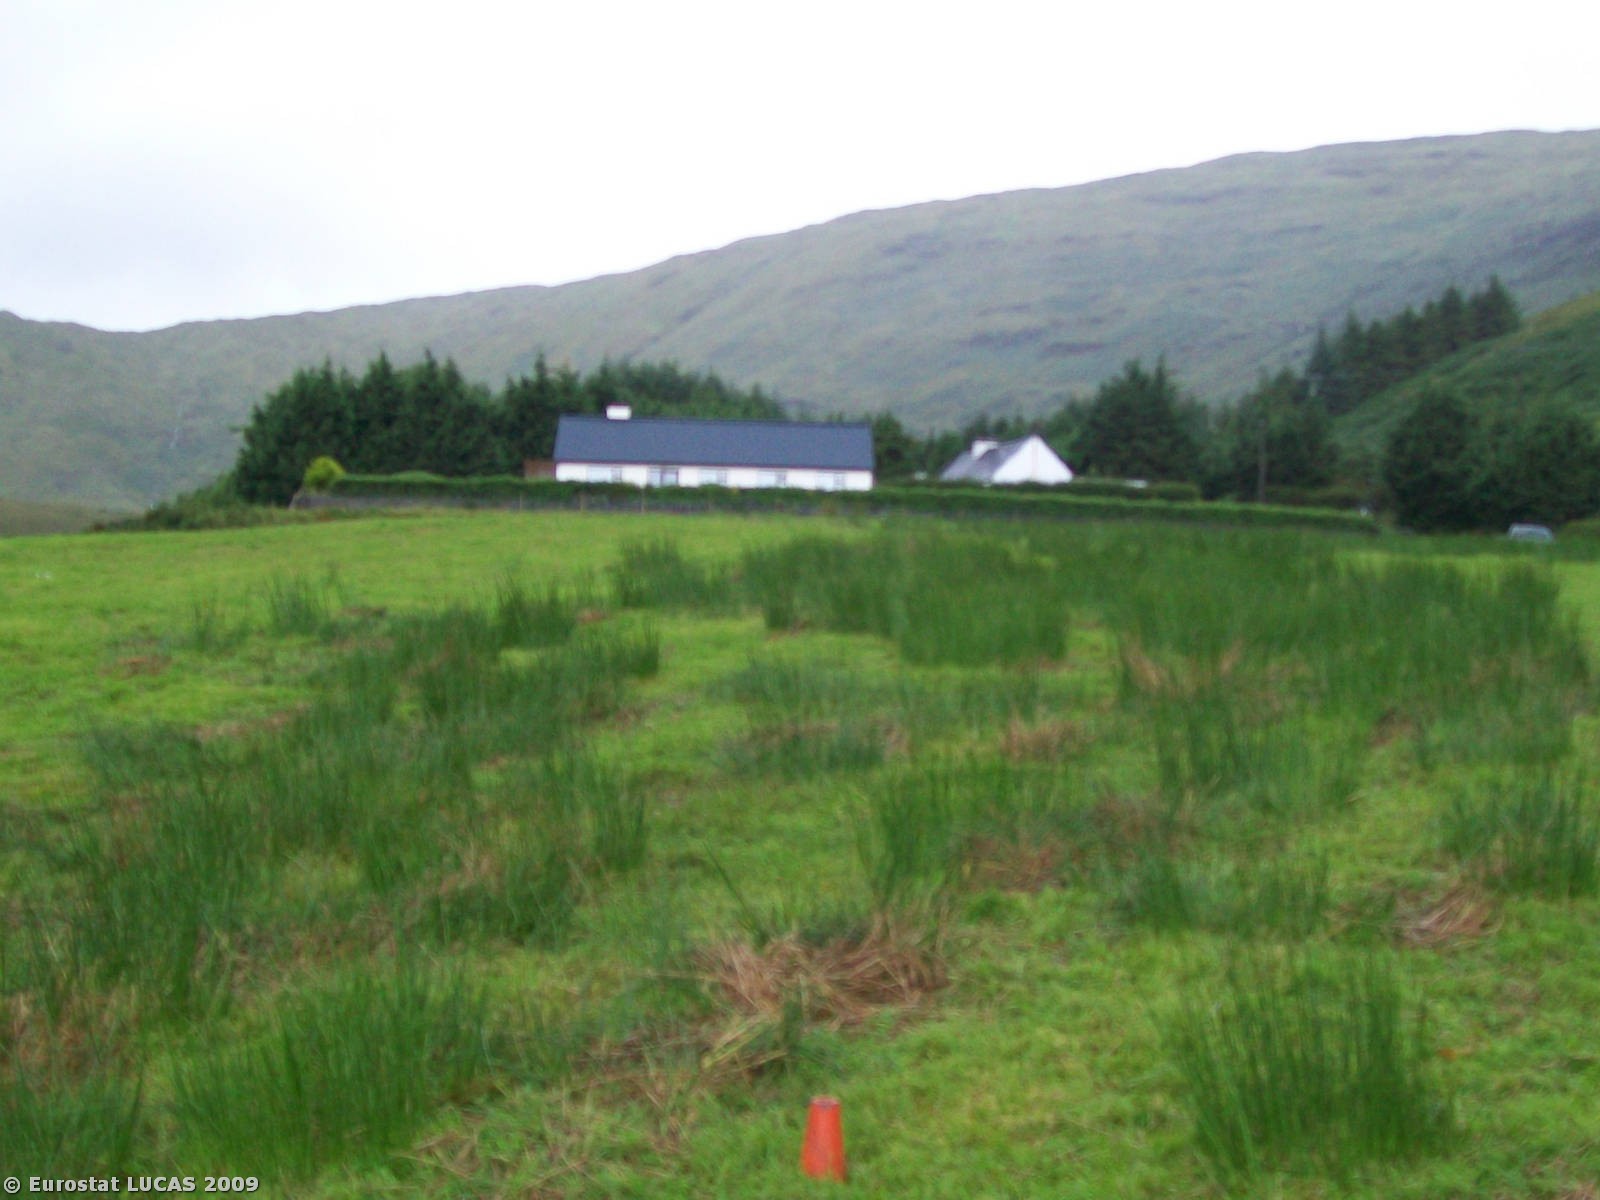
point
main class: Grassland
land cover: Grassland without tree/shrub cover
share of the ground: > 75 %
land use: Agriculture (excluding fallow land and kitchen gardens)
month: July
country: IE
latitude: 53.5309
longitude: -9.5293
